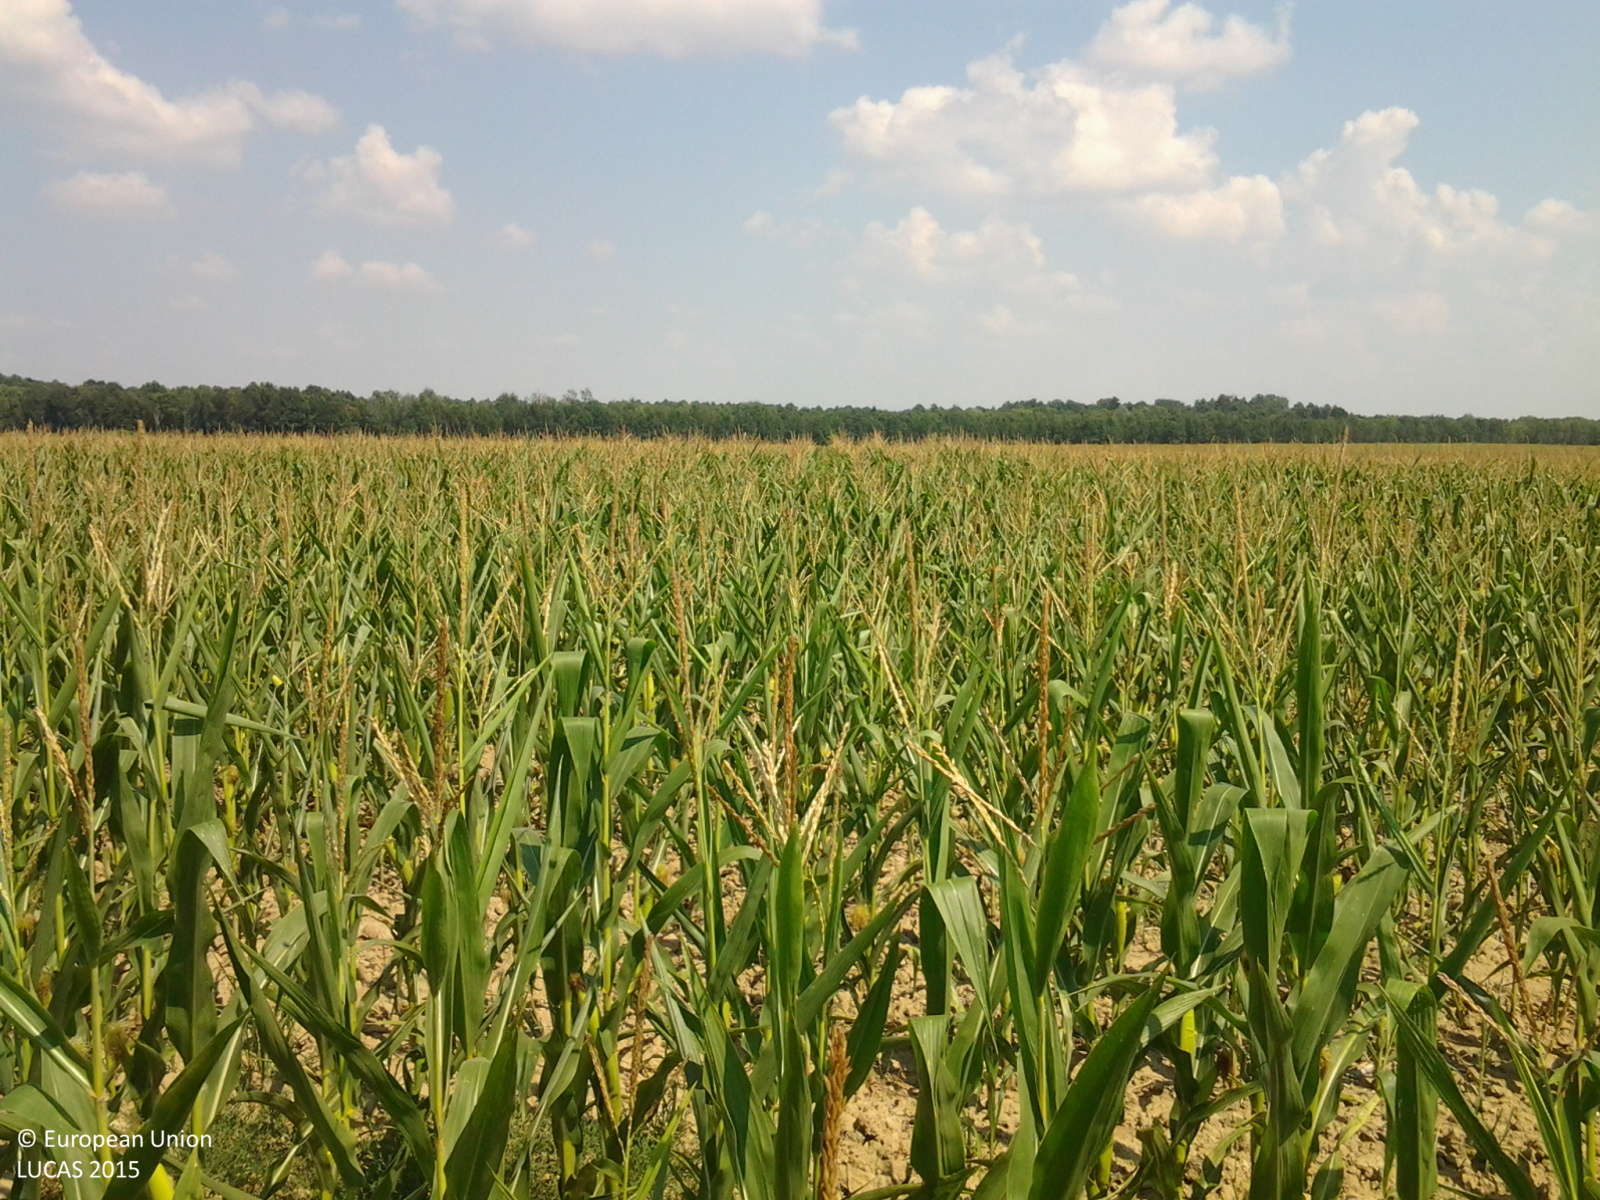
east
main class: Cropland
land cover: Maize
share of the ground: > 75 %
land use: Agriculture (excluding fallow land and kitchen gardens)
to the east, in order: Maize
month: August
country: HU
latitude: 46.3140
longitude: 17.3669
